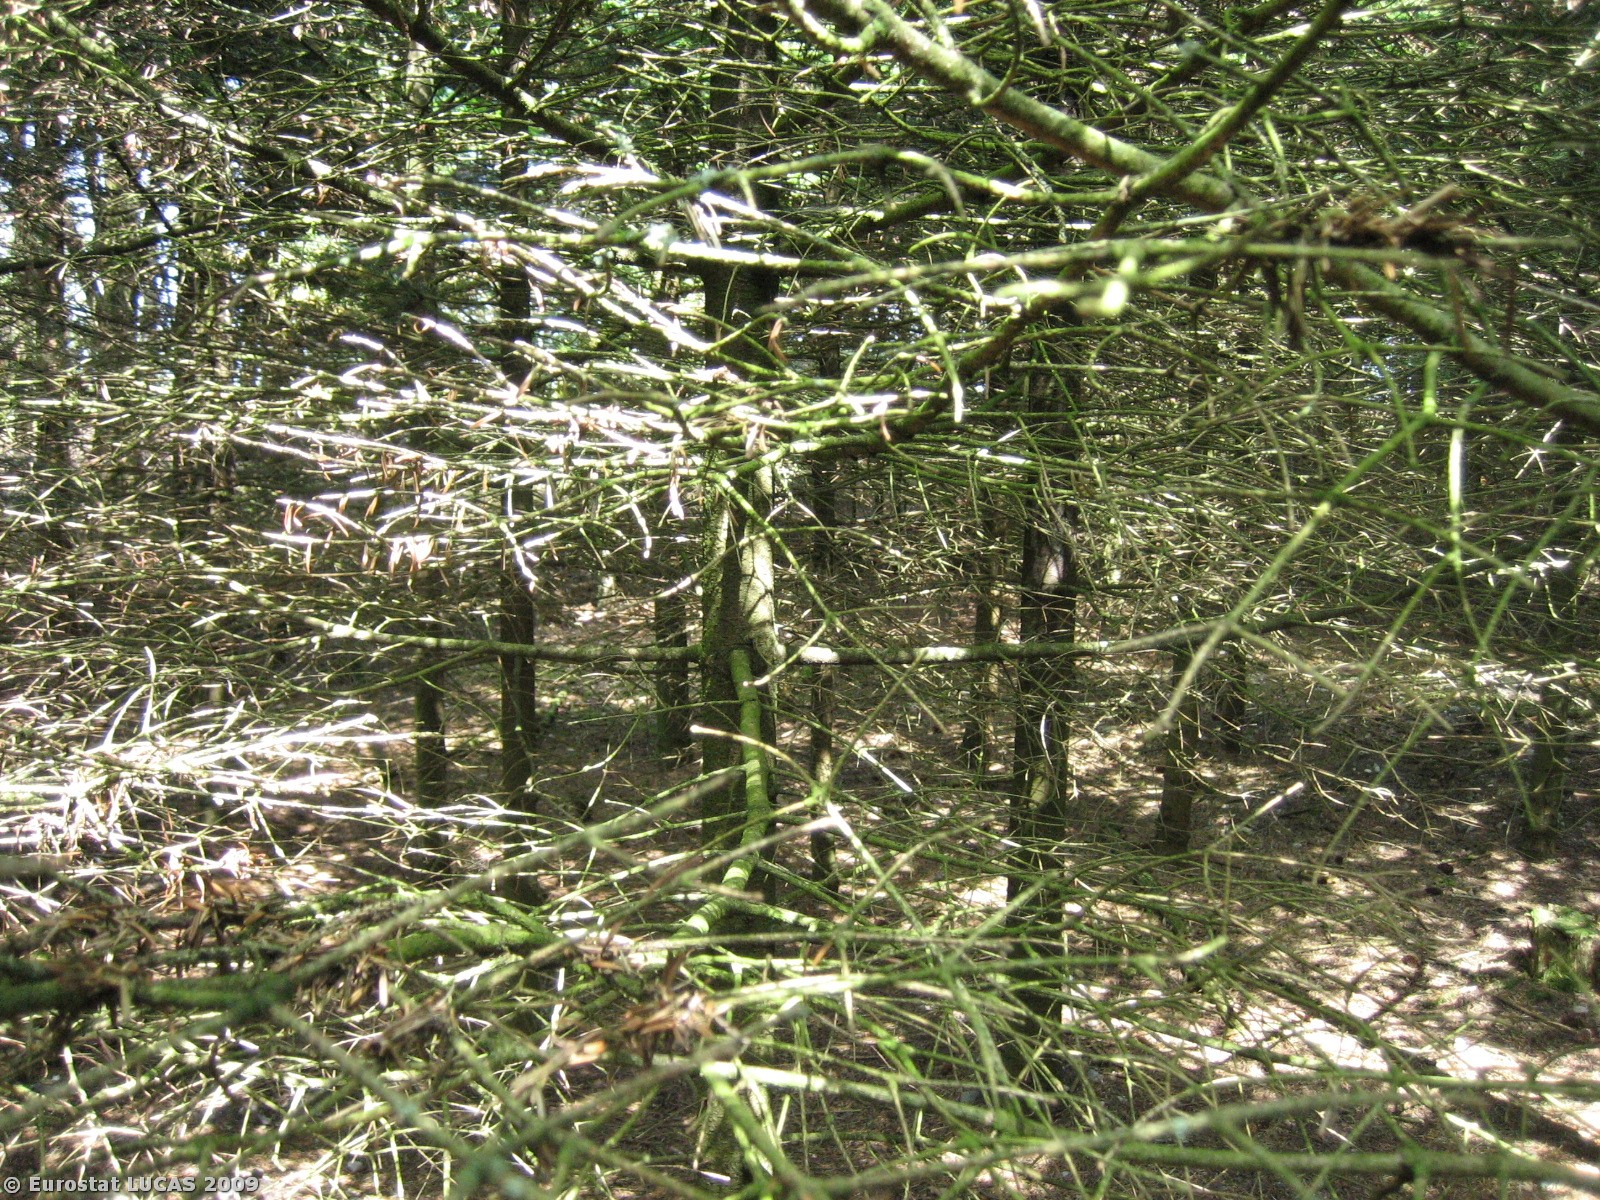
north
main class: Woodland
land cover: Coniferous woodland
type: hemiboreal forest and nemoral coniferous forest and mixed broadleaved-coniferous forest
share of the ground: > 75 %
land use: Forestry
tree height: > 5 m
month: July
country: DK
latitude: 55.6977
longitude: 8.9033
